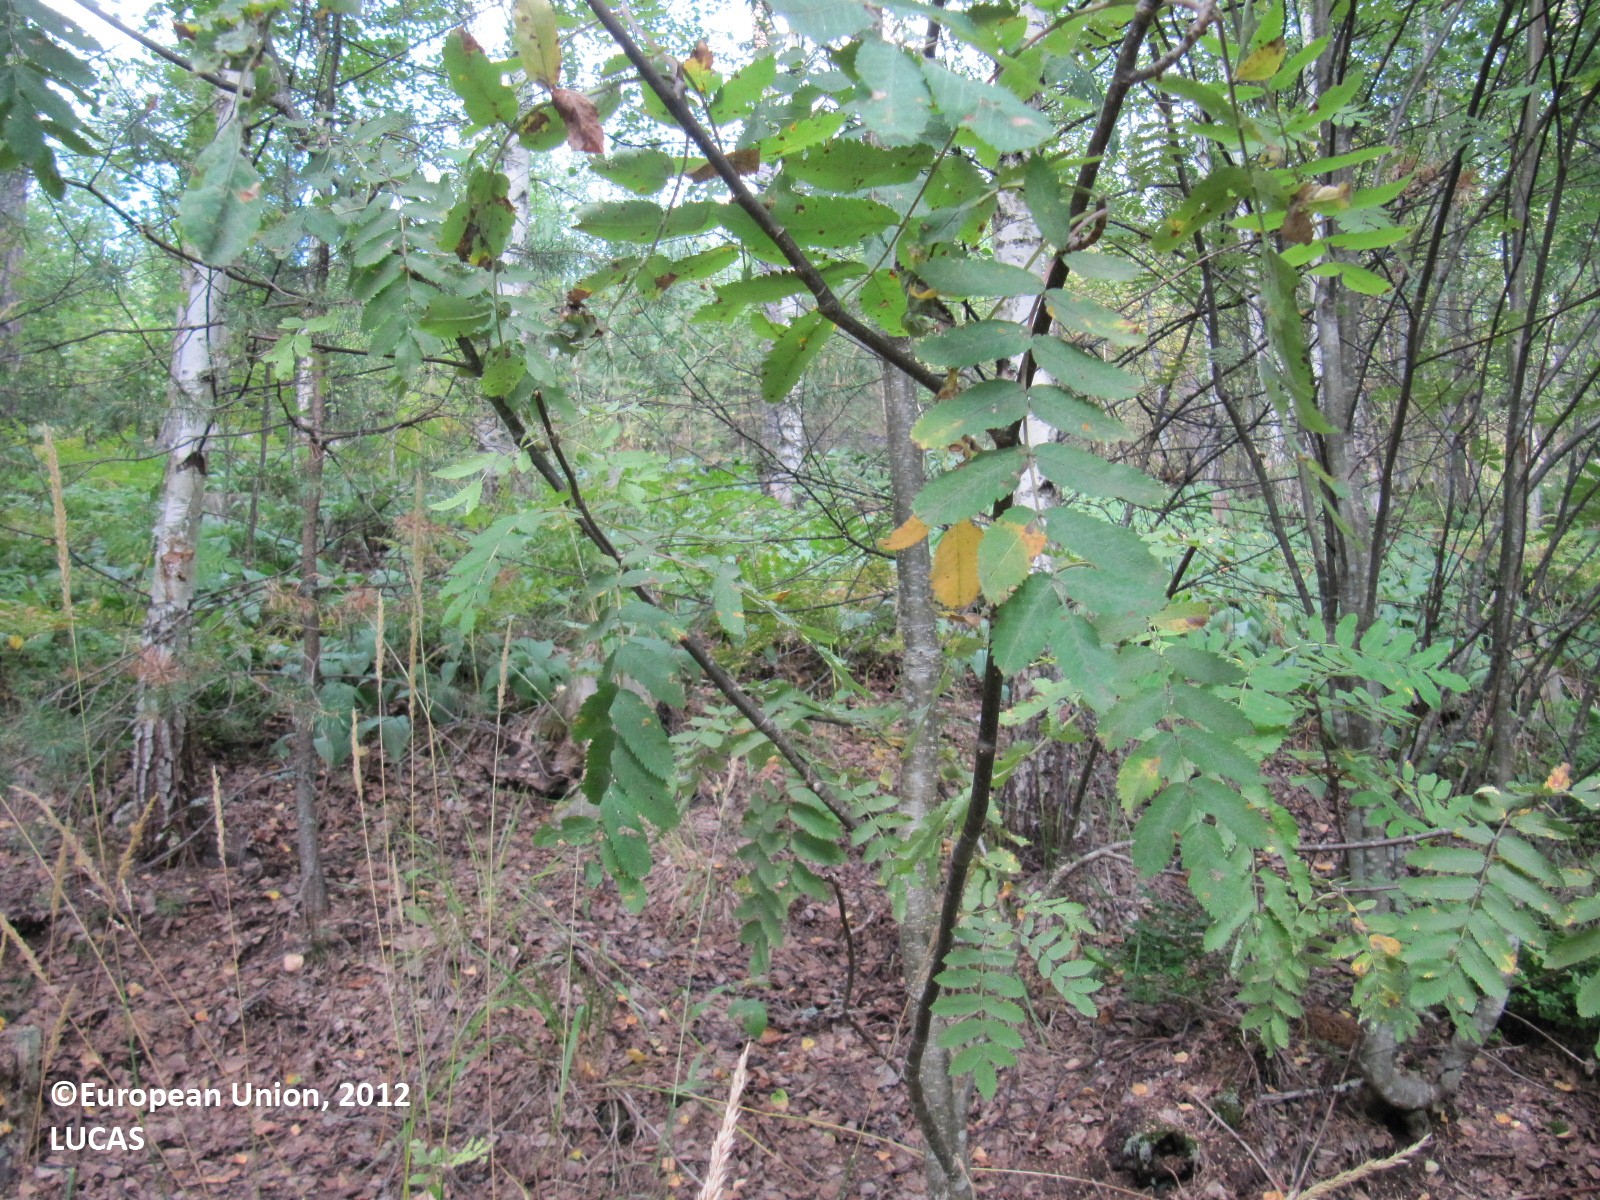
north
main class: Woodland
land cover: Broadleaved woodland
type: boreal forest
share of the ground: > 75 %
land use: Forestry
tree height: > 5 m
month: August
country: FI
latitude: 60.4306
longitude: 24.3649
